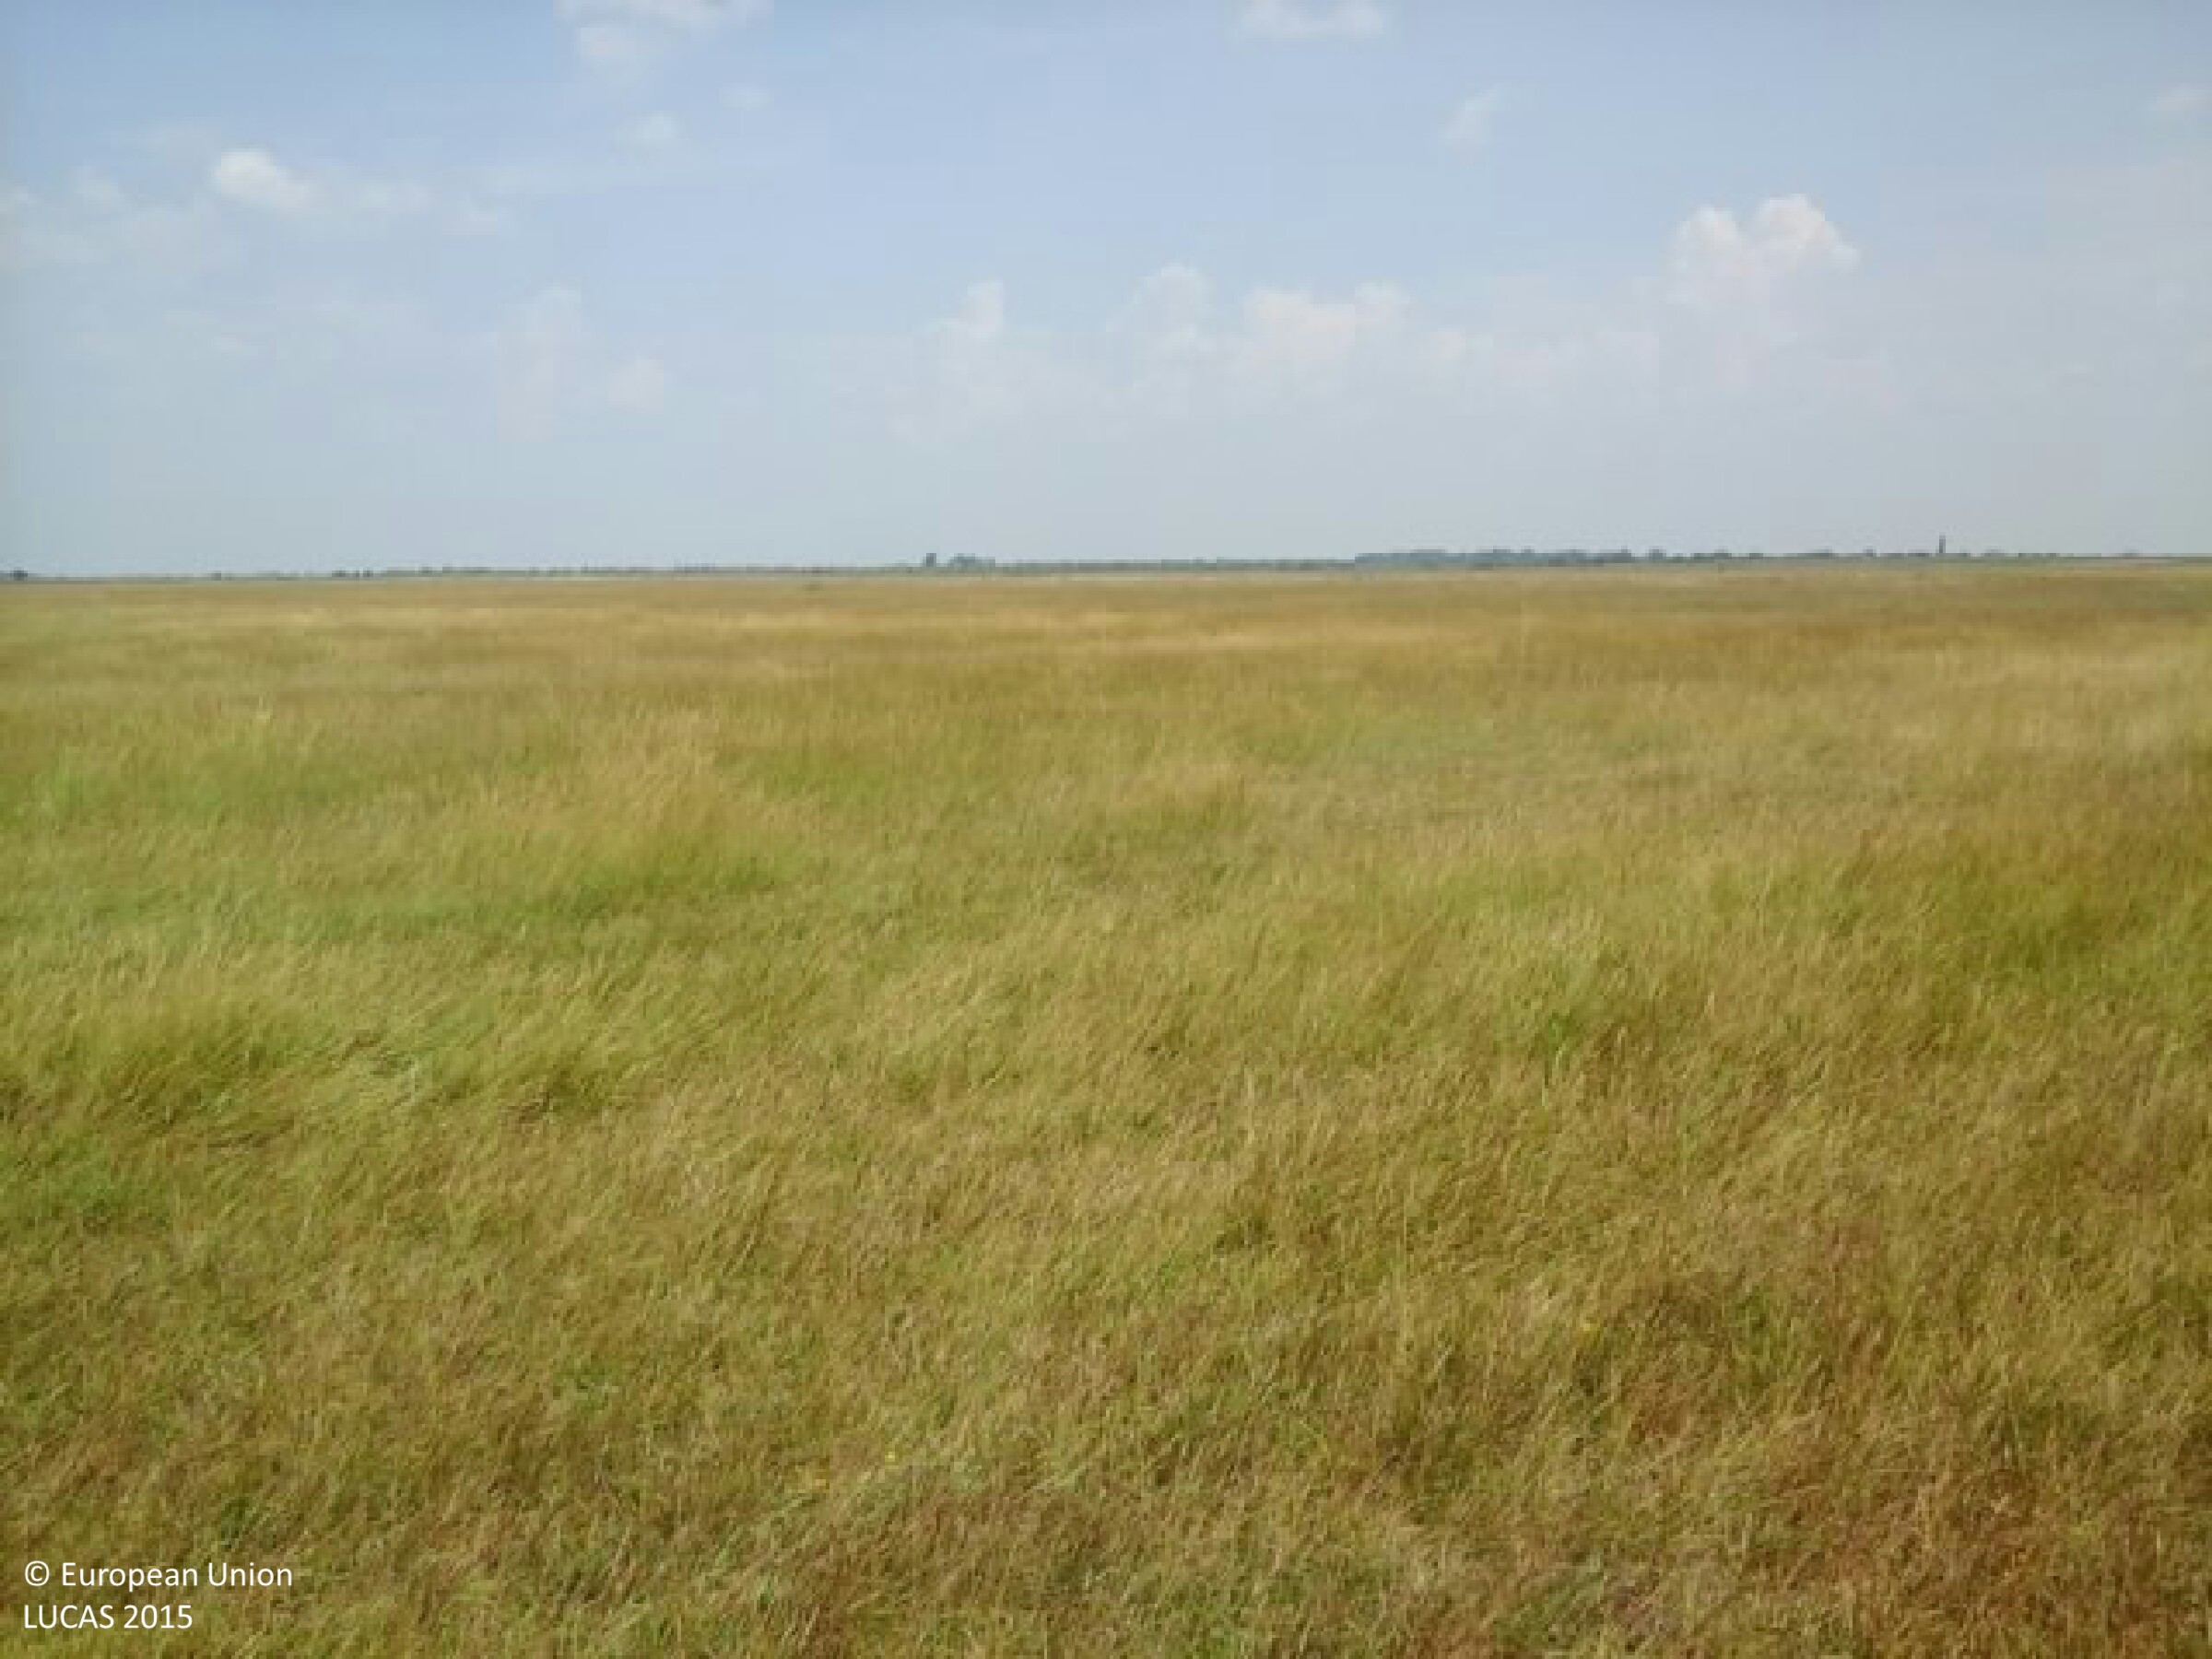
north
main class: Grassland
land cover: Grassland without tree/shrub cover
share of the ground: > 75 %
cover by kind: herbaceous plants 100 %
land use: Agriculture (excluding fallow land and kitchen gardens)
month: August
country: HU
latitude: 47.0709
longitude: 19.0631
